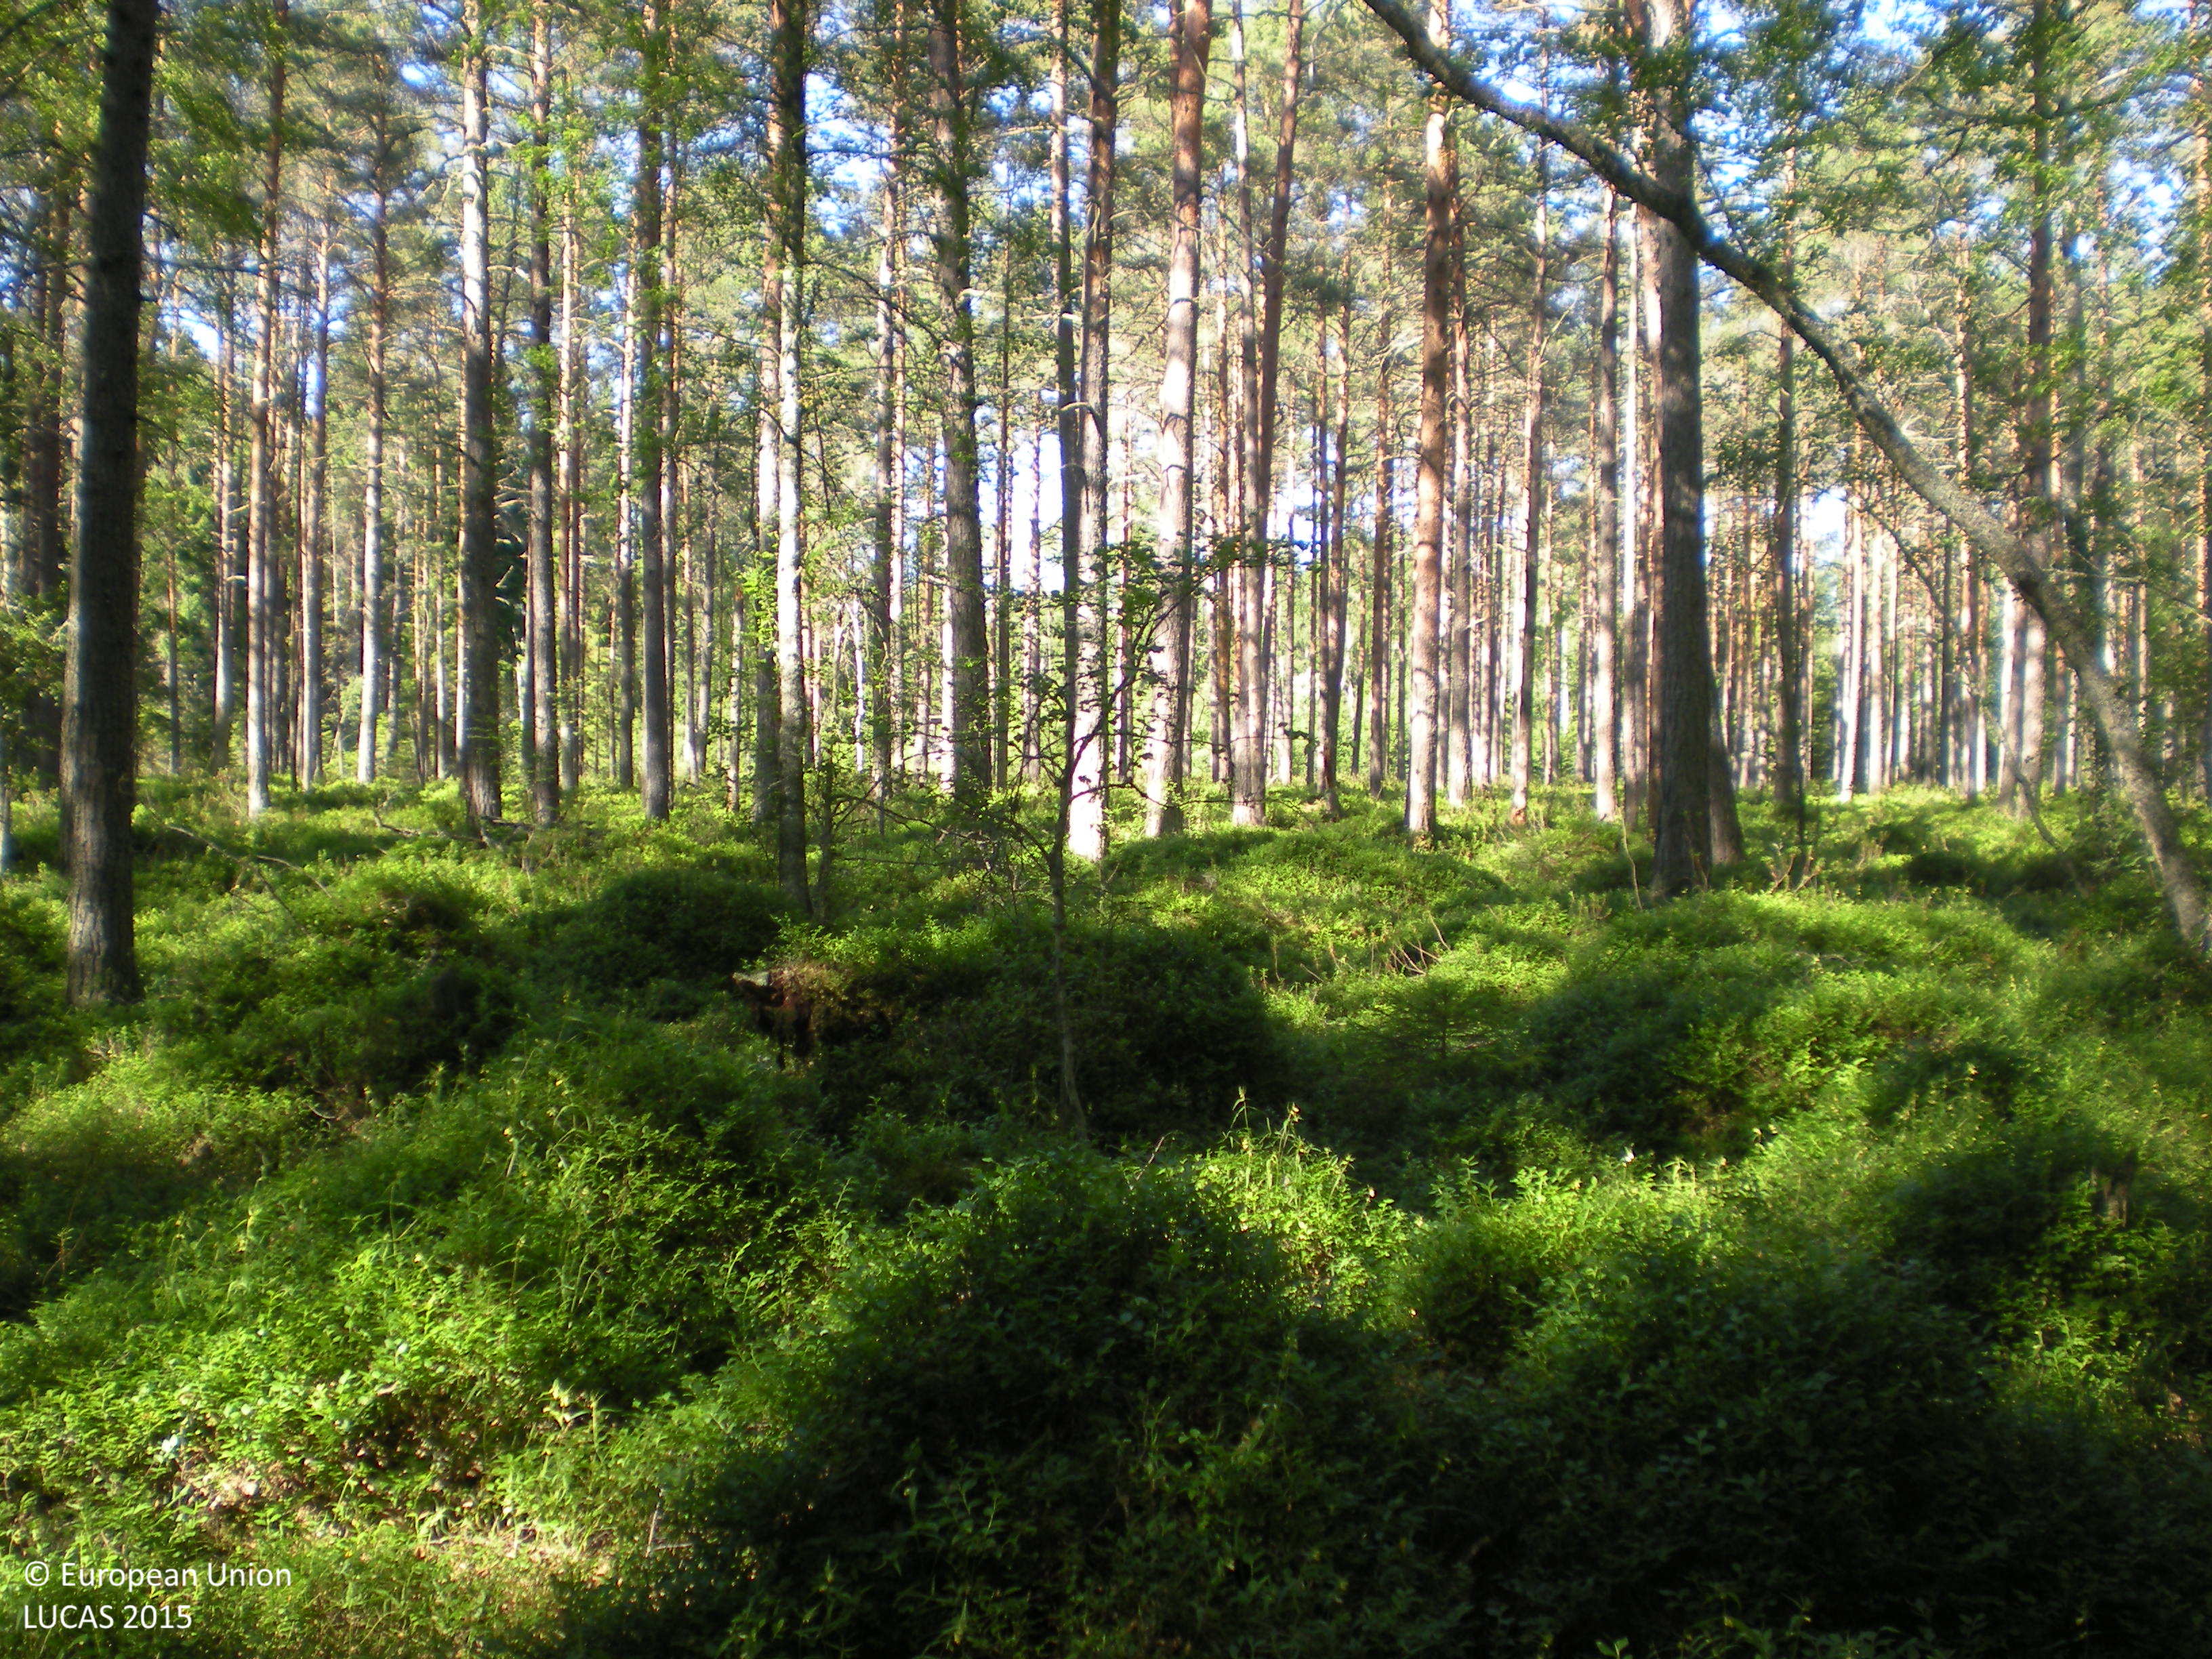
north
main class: Woodland
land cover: Pine dominated mixed woodland
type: boreal forest
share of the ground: 50 - 75 %
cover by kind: coniferous forest trees 60 %, broadleaved forest trees 20 %, shrubs 15 %, herbaceous plants 5 %
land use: Forestry
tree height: > 5 m
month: July
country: SE
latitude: 60.5274
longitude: 17.7720
